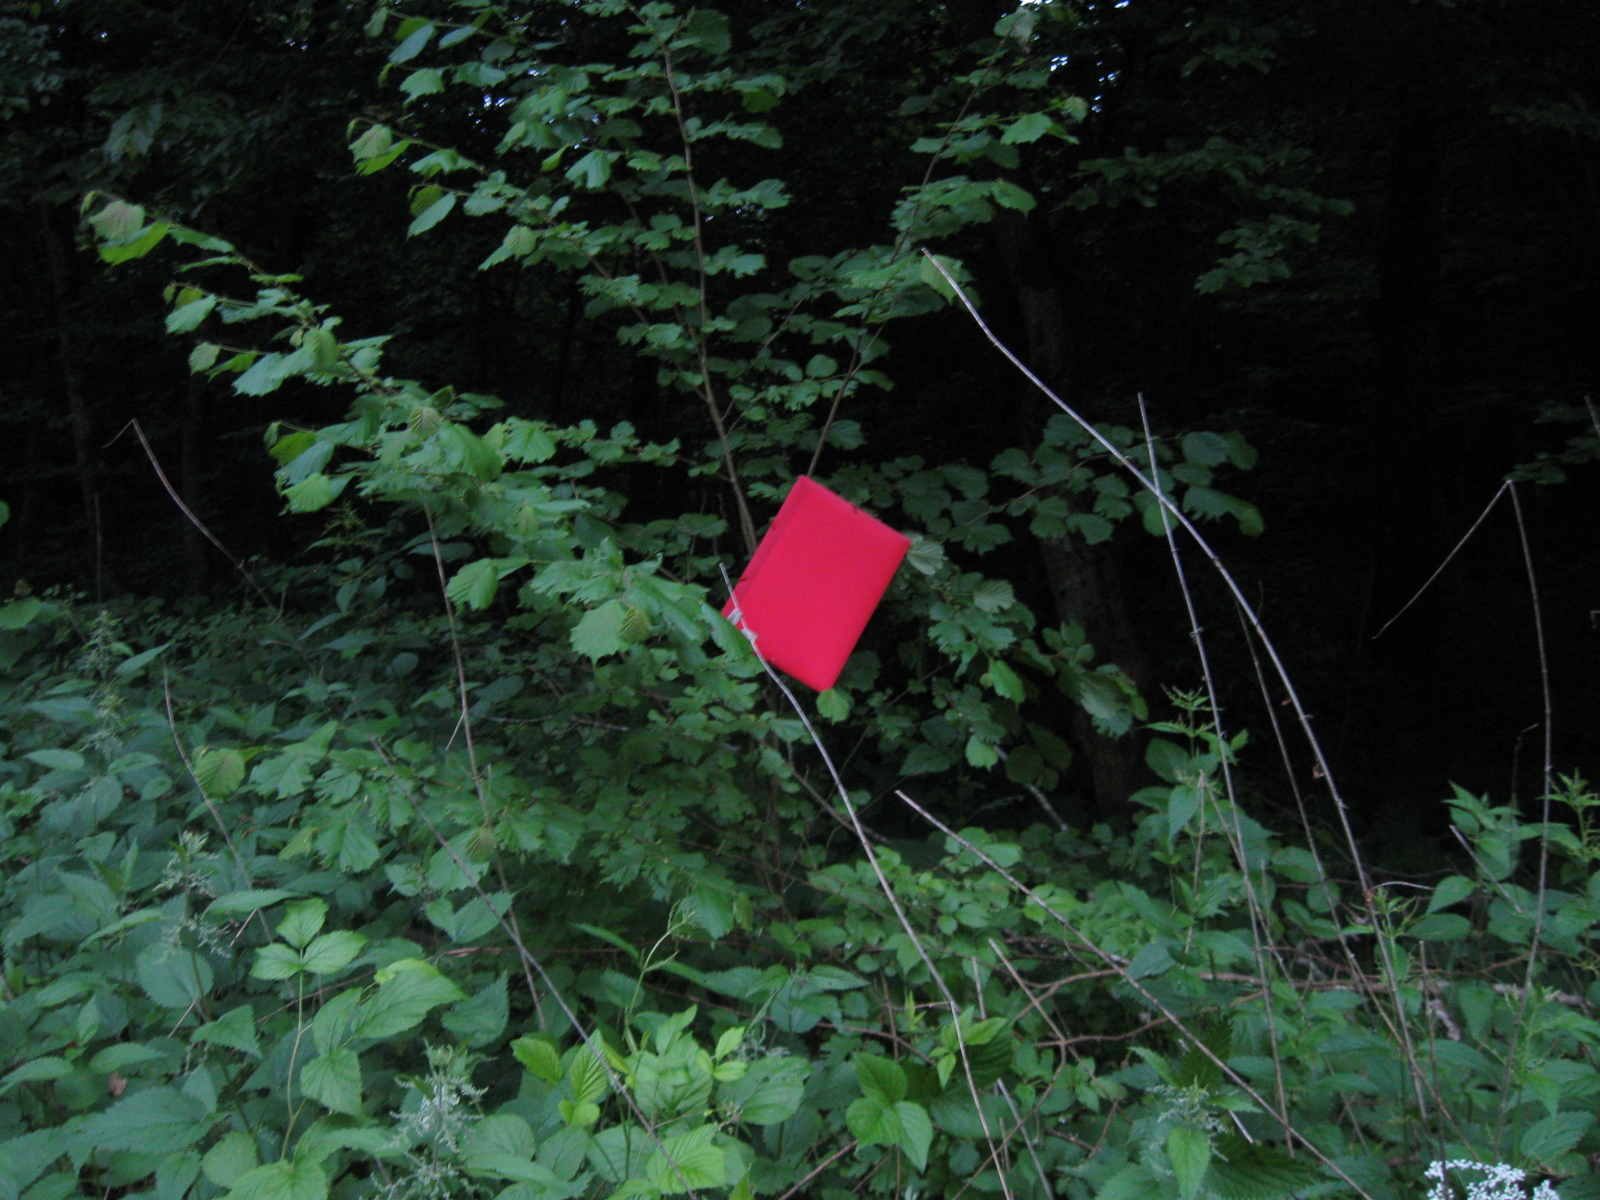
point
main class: Woodland
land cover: Broadleaved woodland
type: non-riverine alder, birch or aspen forest
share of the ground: > 75 %
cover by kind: broadleaved forest trees 80 %, coniferous forest trees 10 %, herbaceous plants 10 %
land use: Forestry
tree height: > 5 m
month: June
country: LT
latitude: 54.6656
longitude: 24.4744
